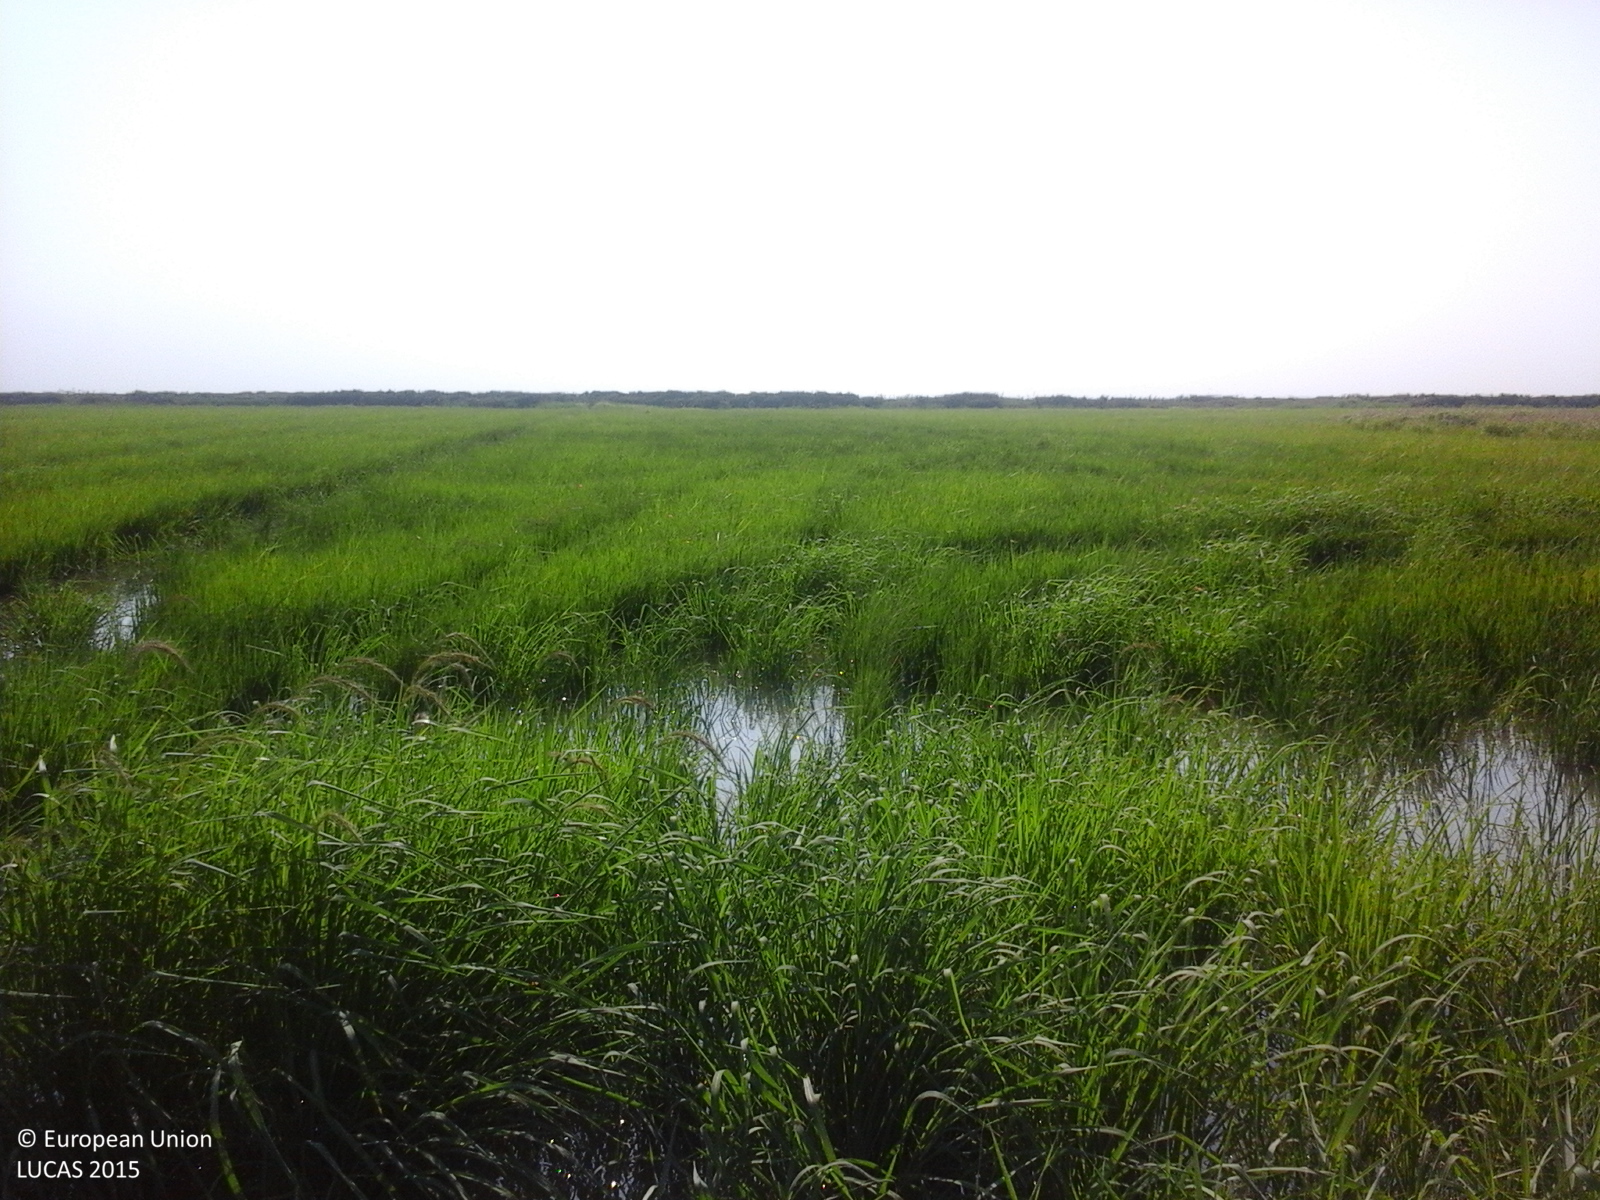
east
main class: Cropland
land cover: Rice
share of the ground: > 75 %
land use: Agriculture (excluding fallow land and kitchen gardens)
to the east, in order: Rice; Ditches and canals; Rice
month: August
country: RO
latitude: 45.3733
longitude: 27.8216
